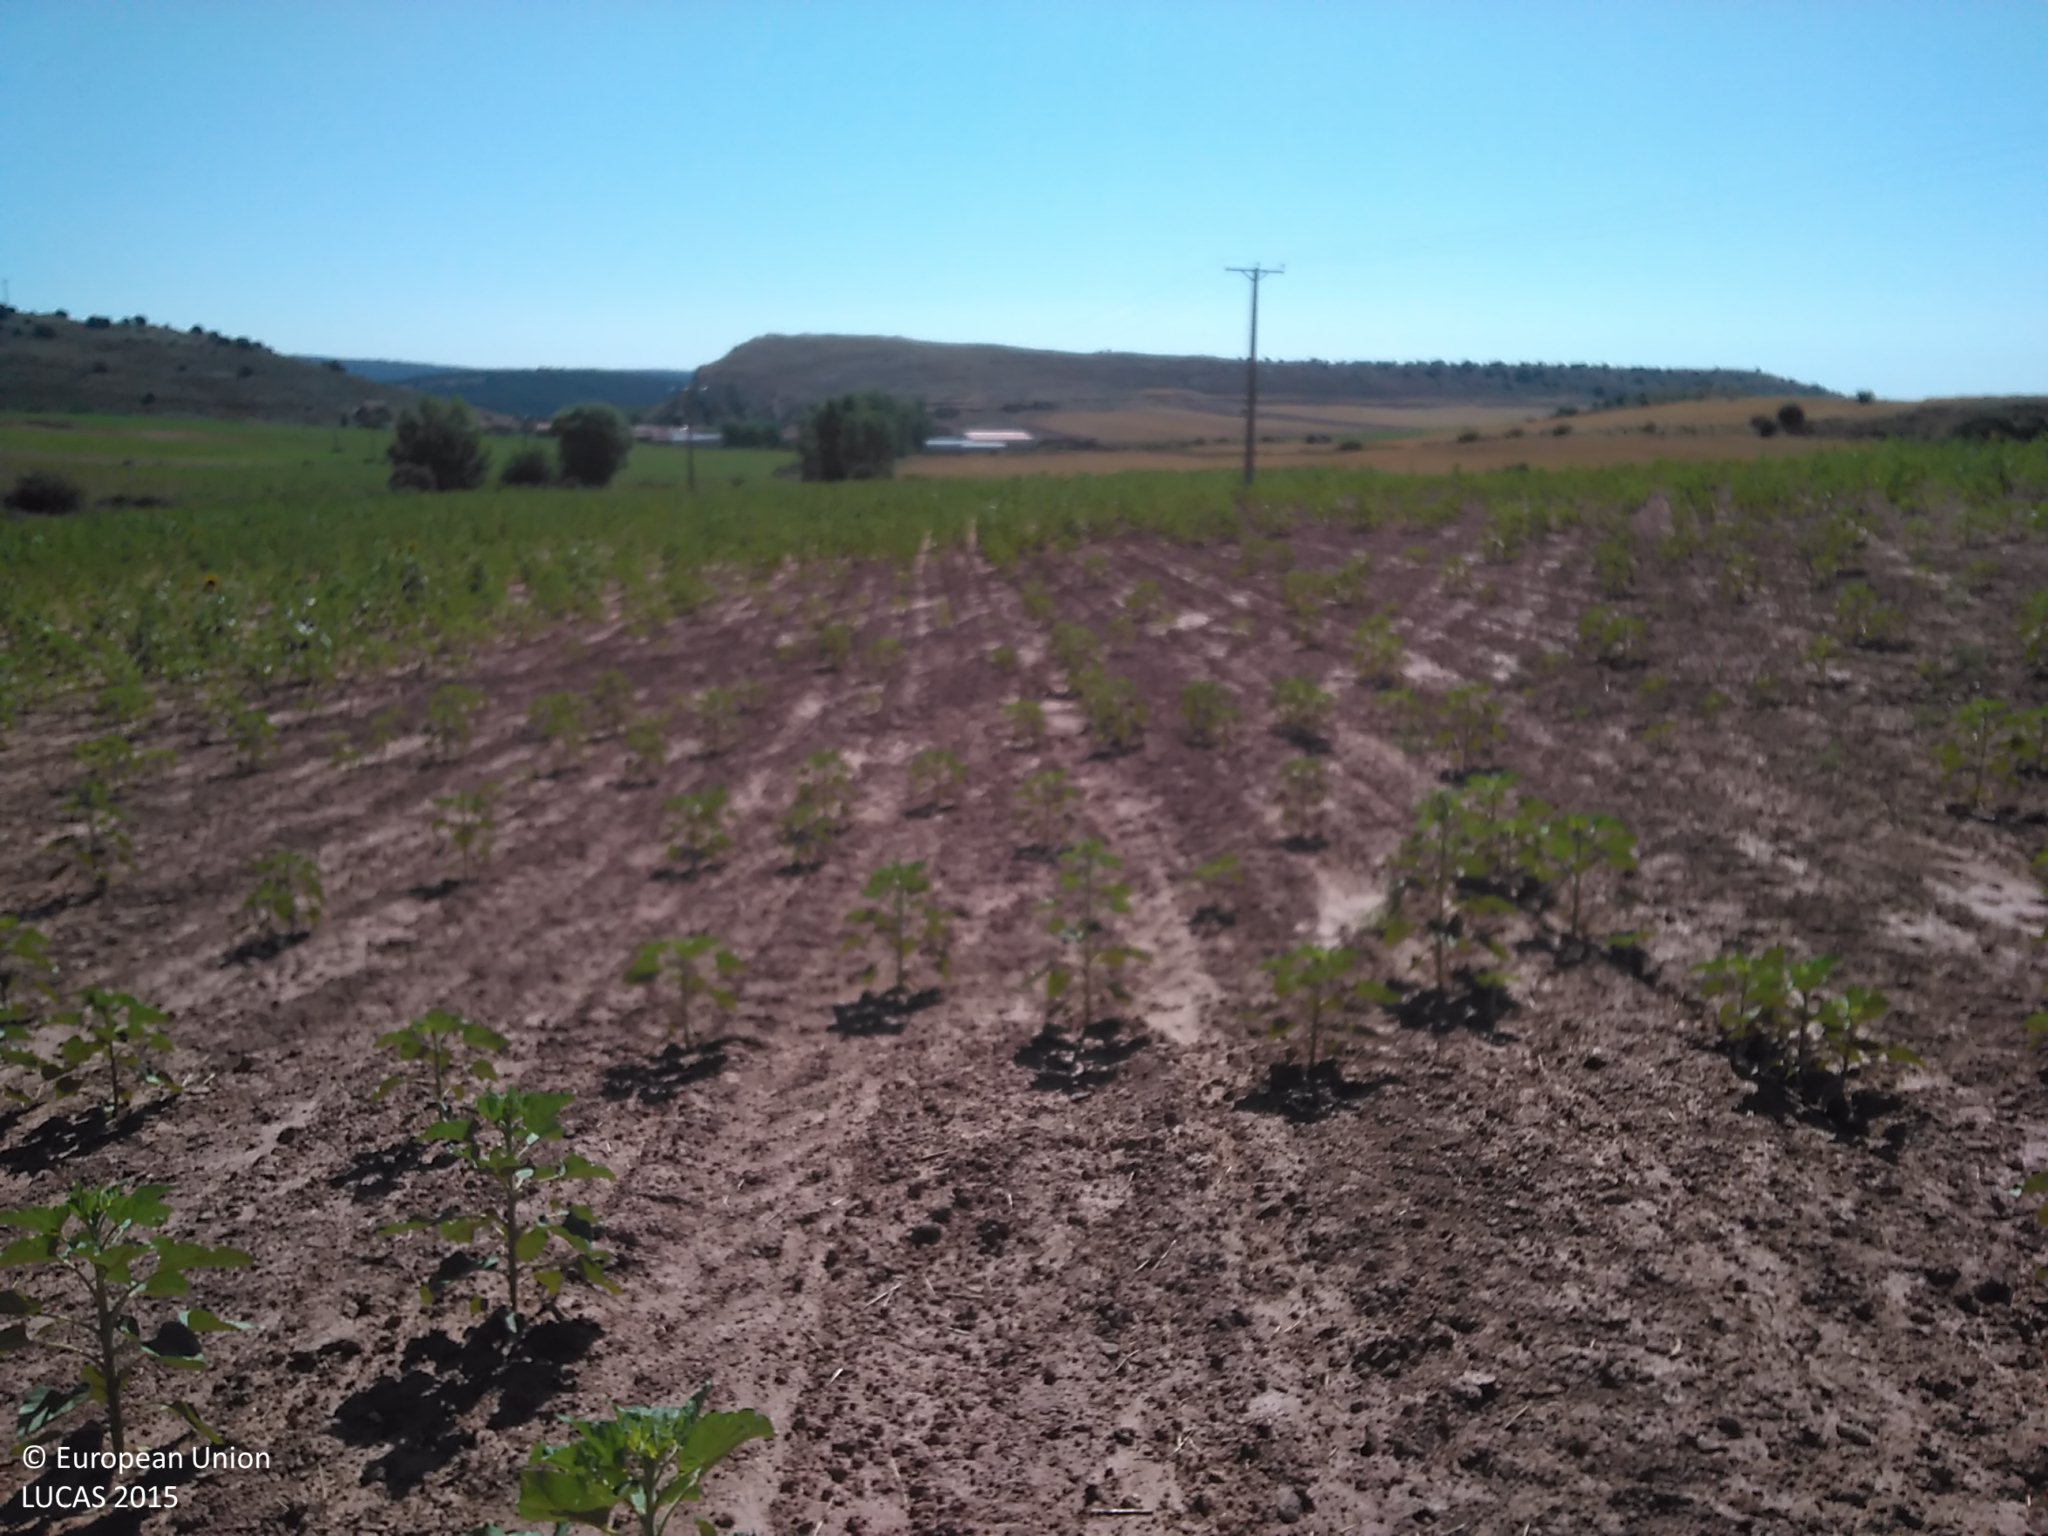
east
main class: Cropland
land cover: Sunflower
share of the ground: 10 - 25 %
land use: Agriculture (excluding fallow land and kitchen gardens)
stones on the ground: < 10 %
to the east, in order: Sunflower; Electric lines; Sunflower; Grassland without tree/shrub cover; Common wheat
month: July
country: ES
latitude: 41.5153
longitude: -2.0249
